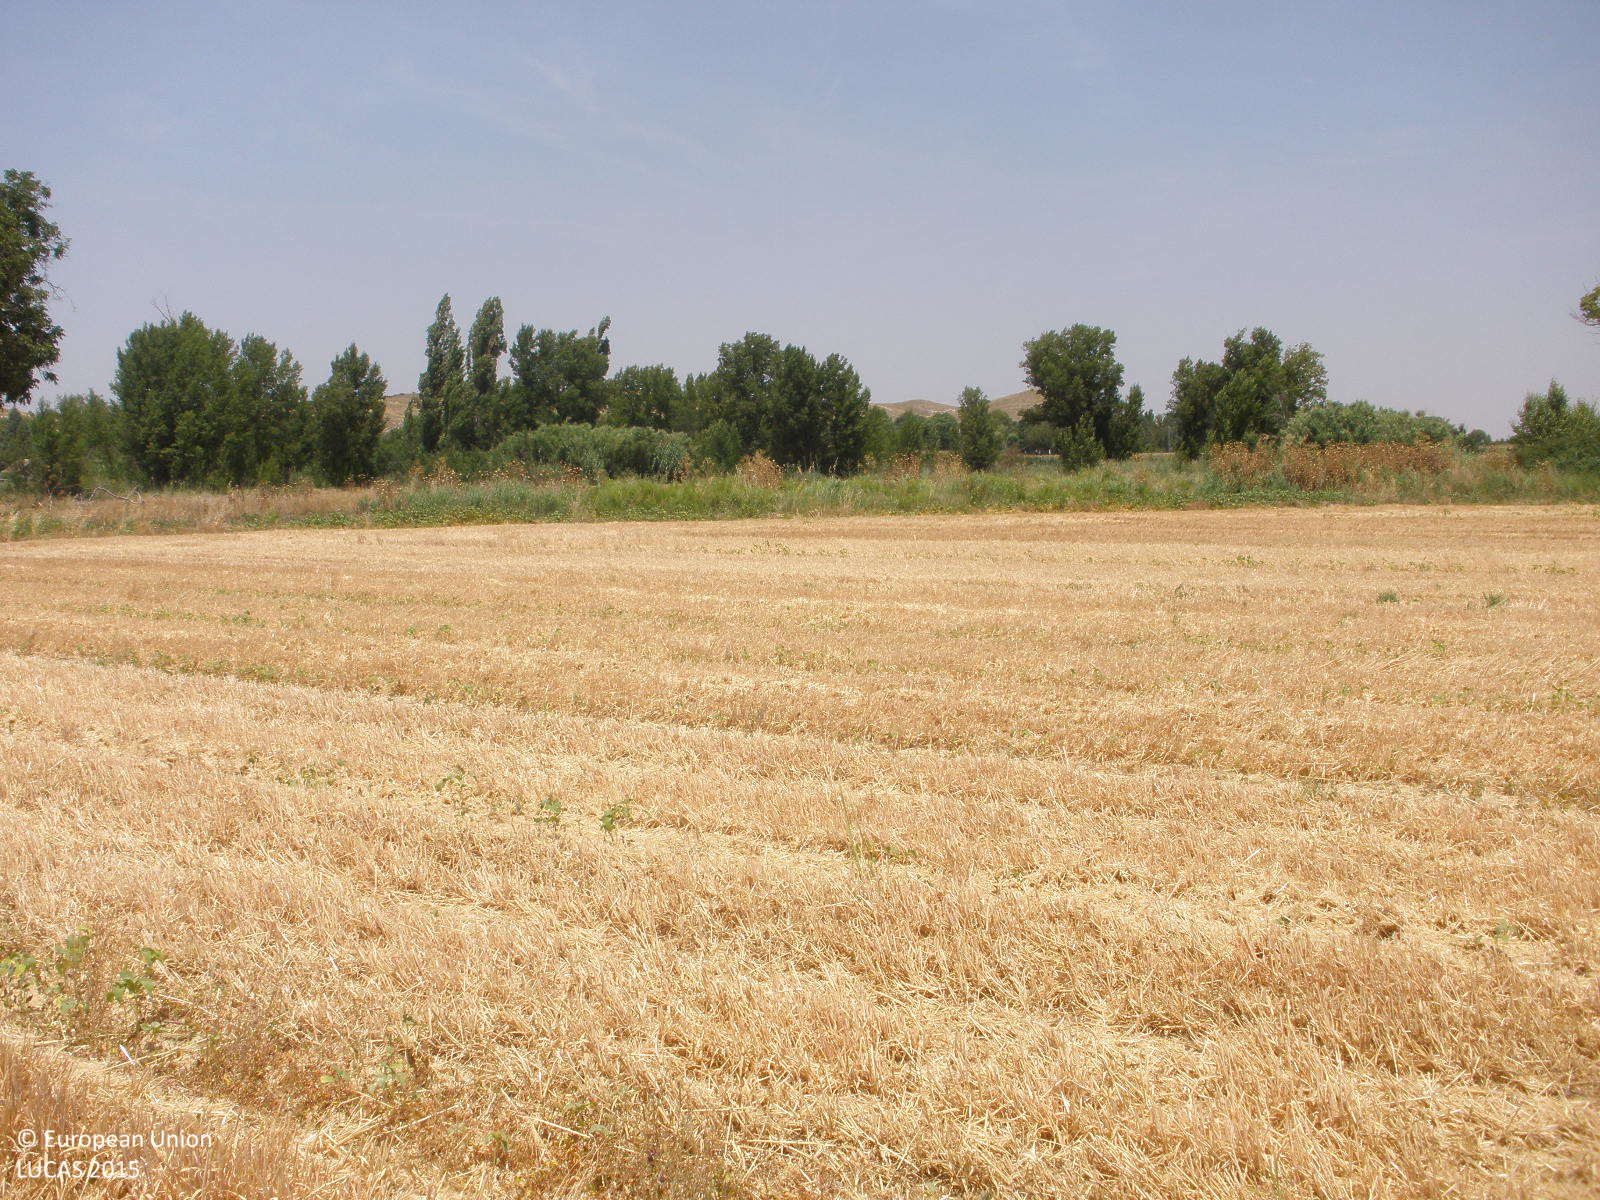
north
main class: Cropland
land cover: Barley
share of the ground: < 10 %
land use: Agriculture (excluding fallow land and kitchen gardens)
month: July
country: ES
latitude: 40.1509
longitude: -3.5200
